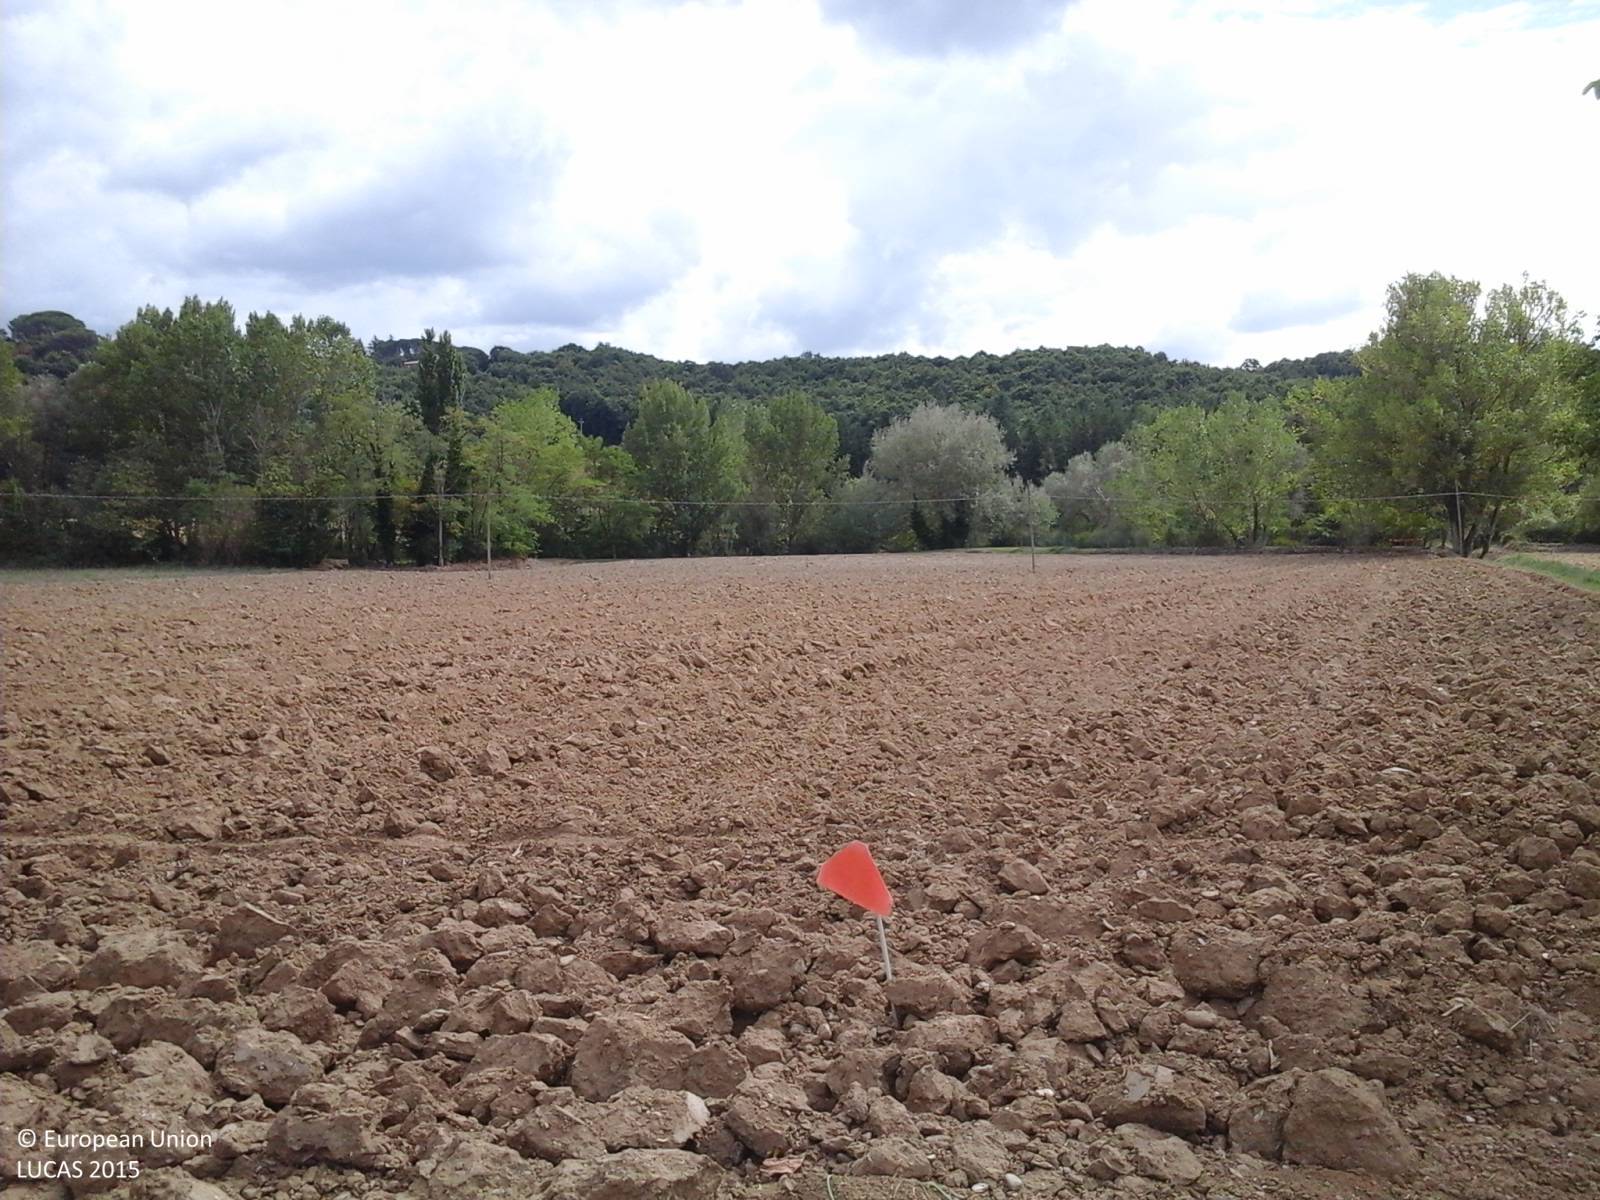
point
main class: Cropland
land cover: Barley
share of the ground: < 10 %
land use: Agriculture (excluding fallow land and kitchen gardens)
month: September
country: IT
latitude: 42.9326
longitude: 12.4067
